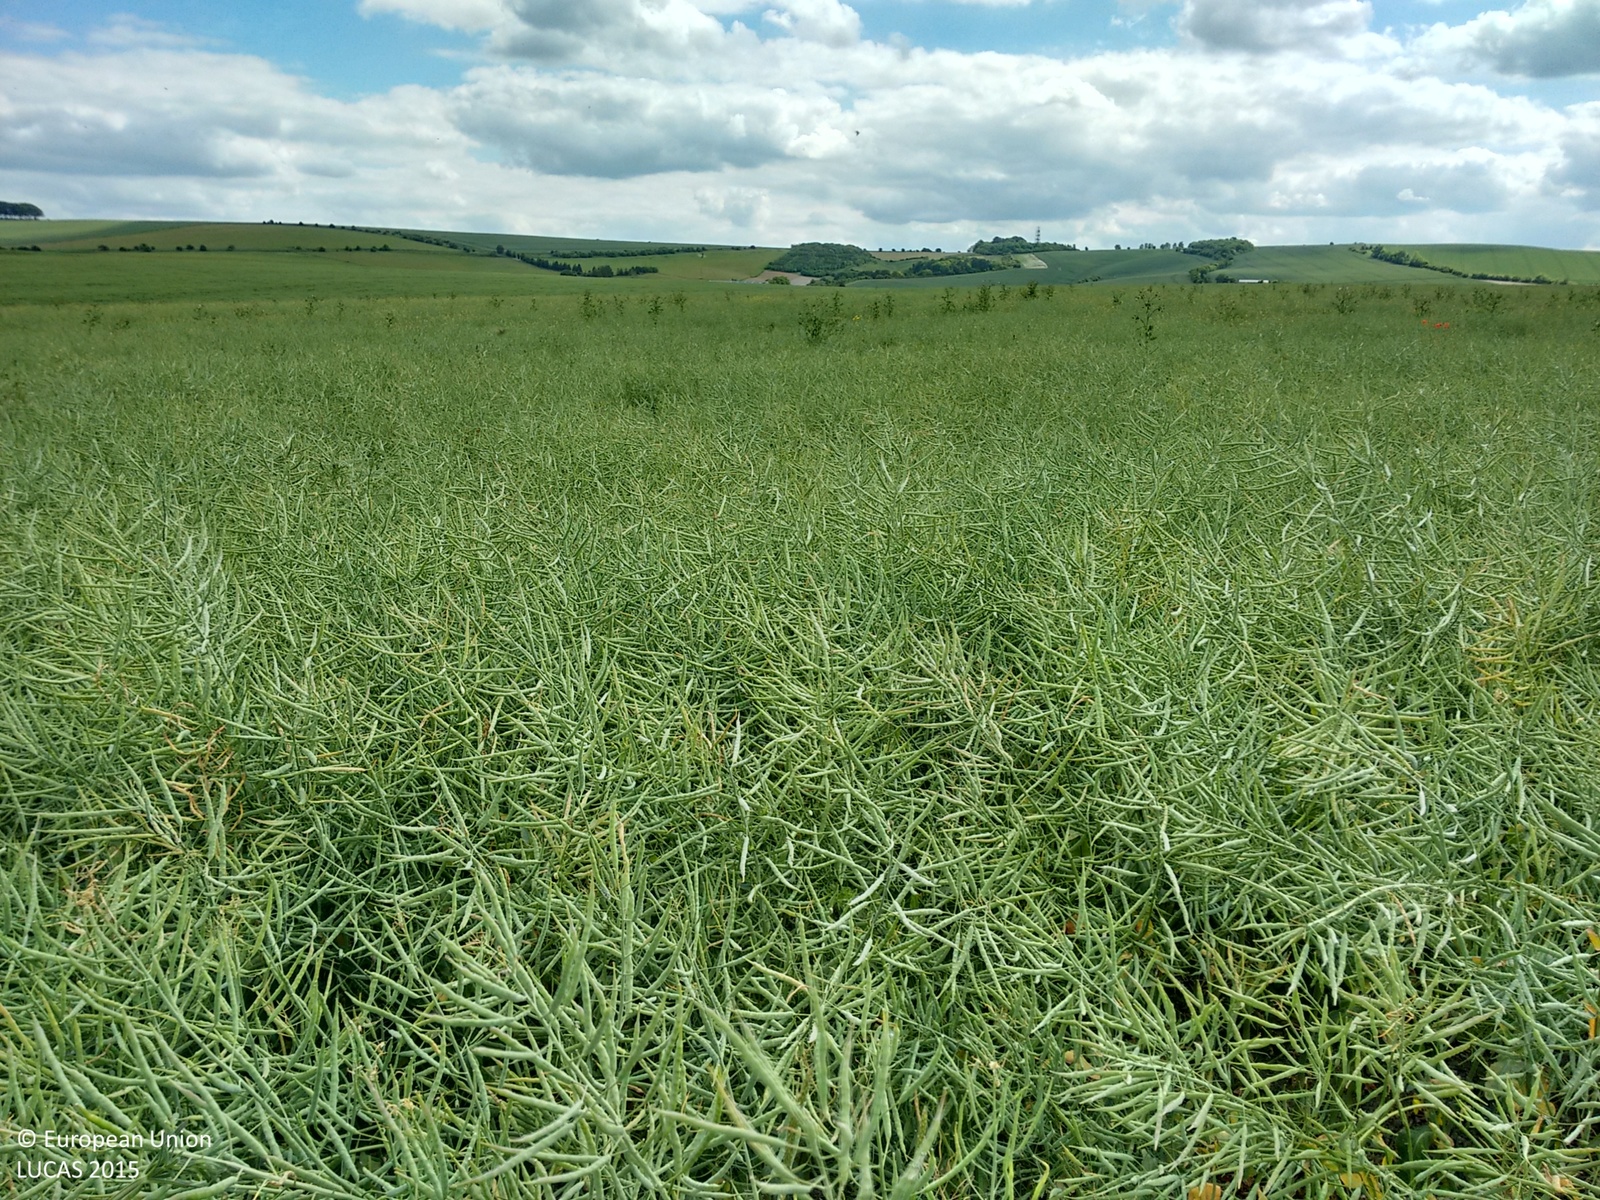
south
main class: Cropland
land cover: Rape and turnip rape
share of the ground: > 75 %
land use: Agriculture (excluding fallow land and kitchen gardens)
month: June
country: GB
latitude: 51.5808
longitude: -1.4950
